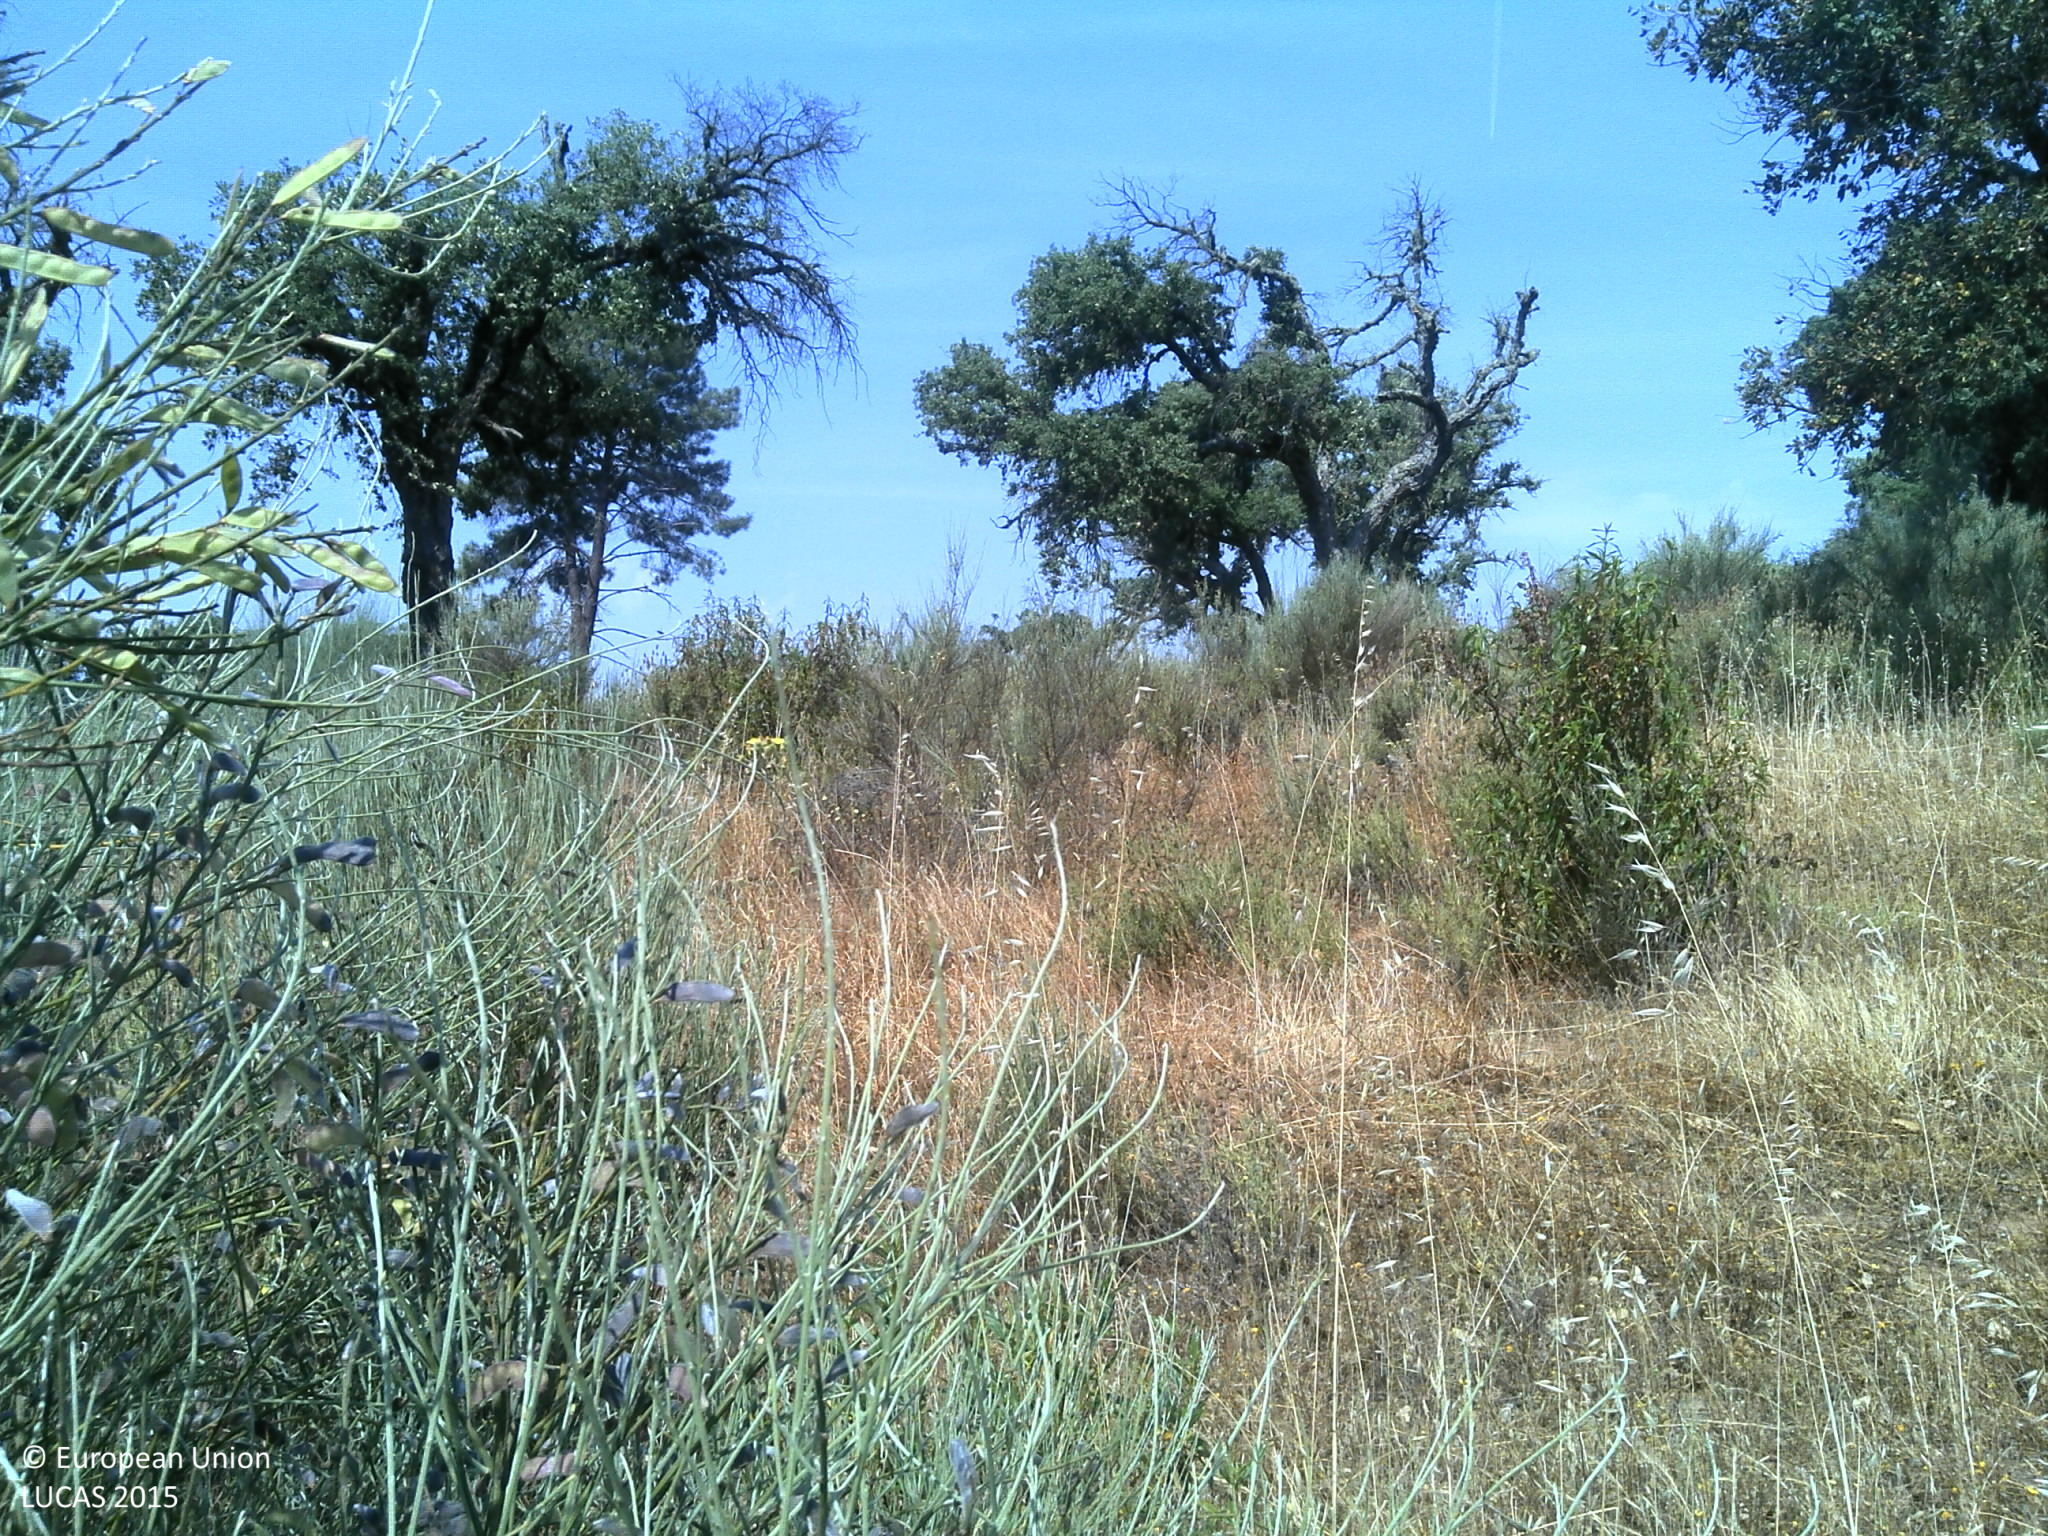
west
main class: Woodland
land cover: Broadleaved woodland
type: broadleaved evergreen forest
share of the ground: 10 - 25 %
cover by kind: shrubs 40 %, herbaceous plants 25 %, broadleaved forest trees 15 %, consolidated bare surface 10 %, unconsolidated bare surface 10 %
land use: Forestry
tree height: > 5 m
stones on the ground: 10 - 25 %
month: June
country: PT
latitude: 41.5489
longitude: -7.0318
